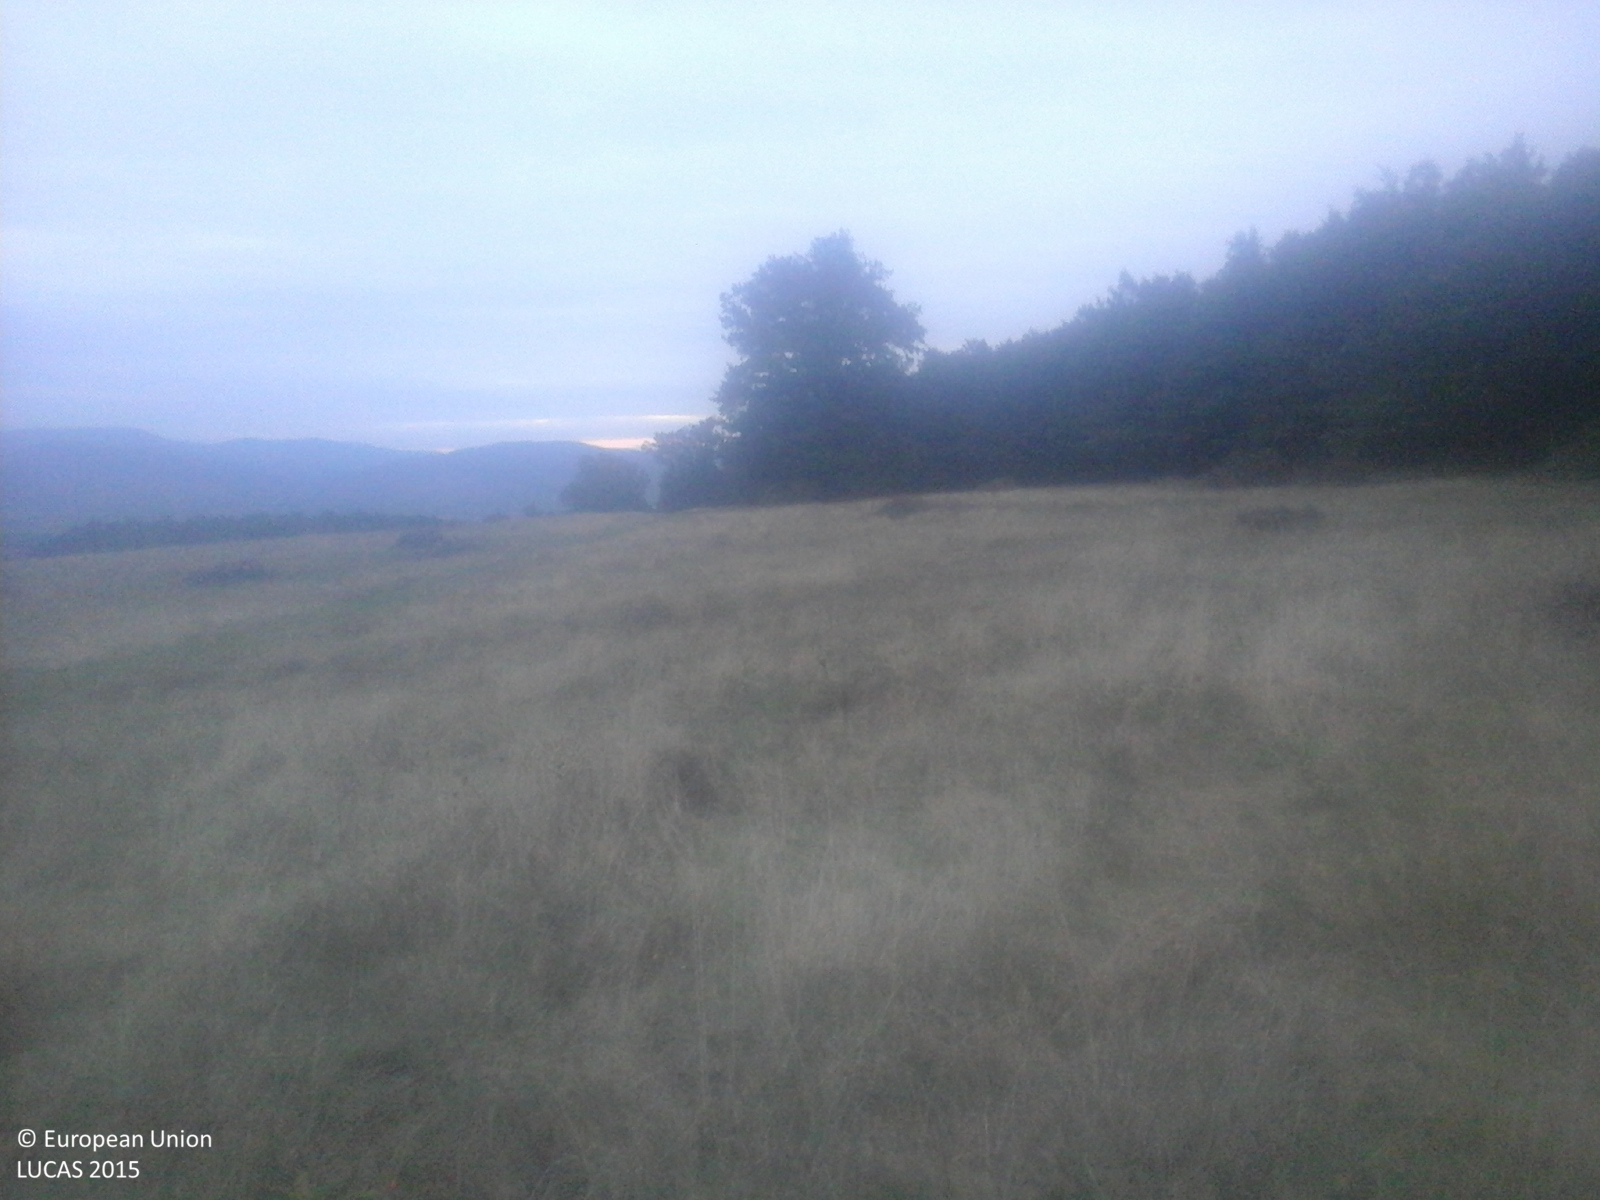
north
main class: Grassland
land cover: Grassland with sparse tree/shrub cover
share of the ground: > 75 %
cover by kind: herbaceous plants 85 %, shrubs 10 %, broadleaved forest trees 5 %
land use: Agriculture (excluding fallow land and kitchen gardens)
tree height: < 5 m
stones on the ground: < 10 %
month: September
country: RO
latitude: 45.8611
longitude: 23.3142
